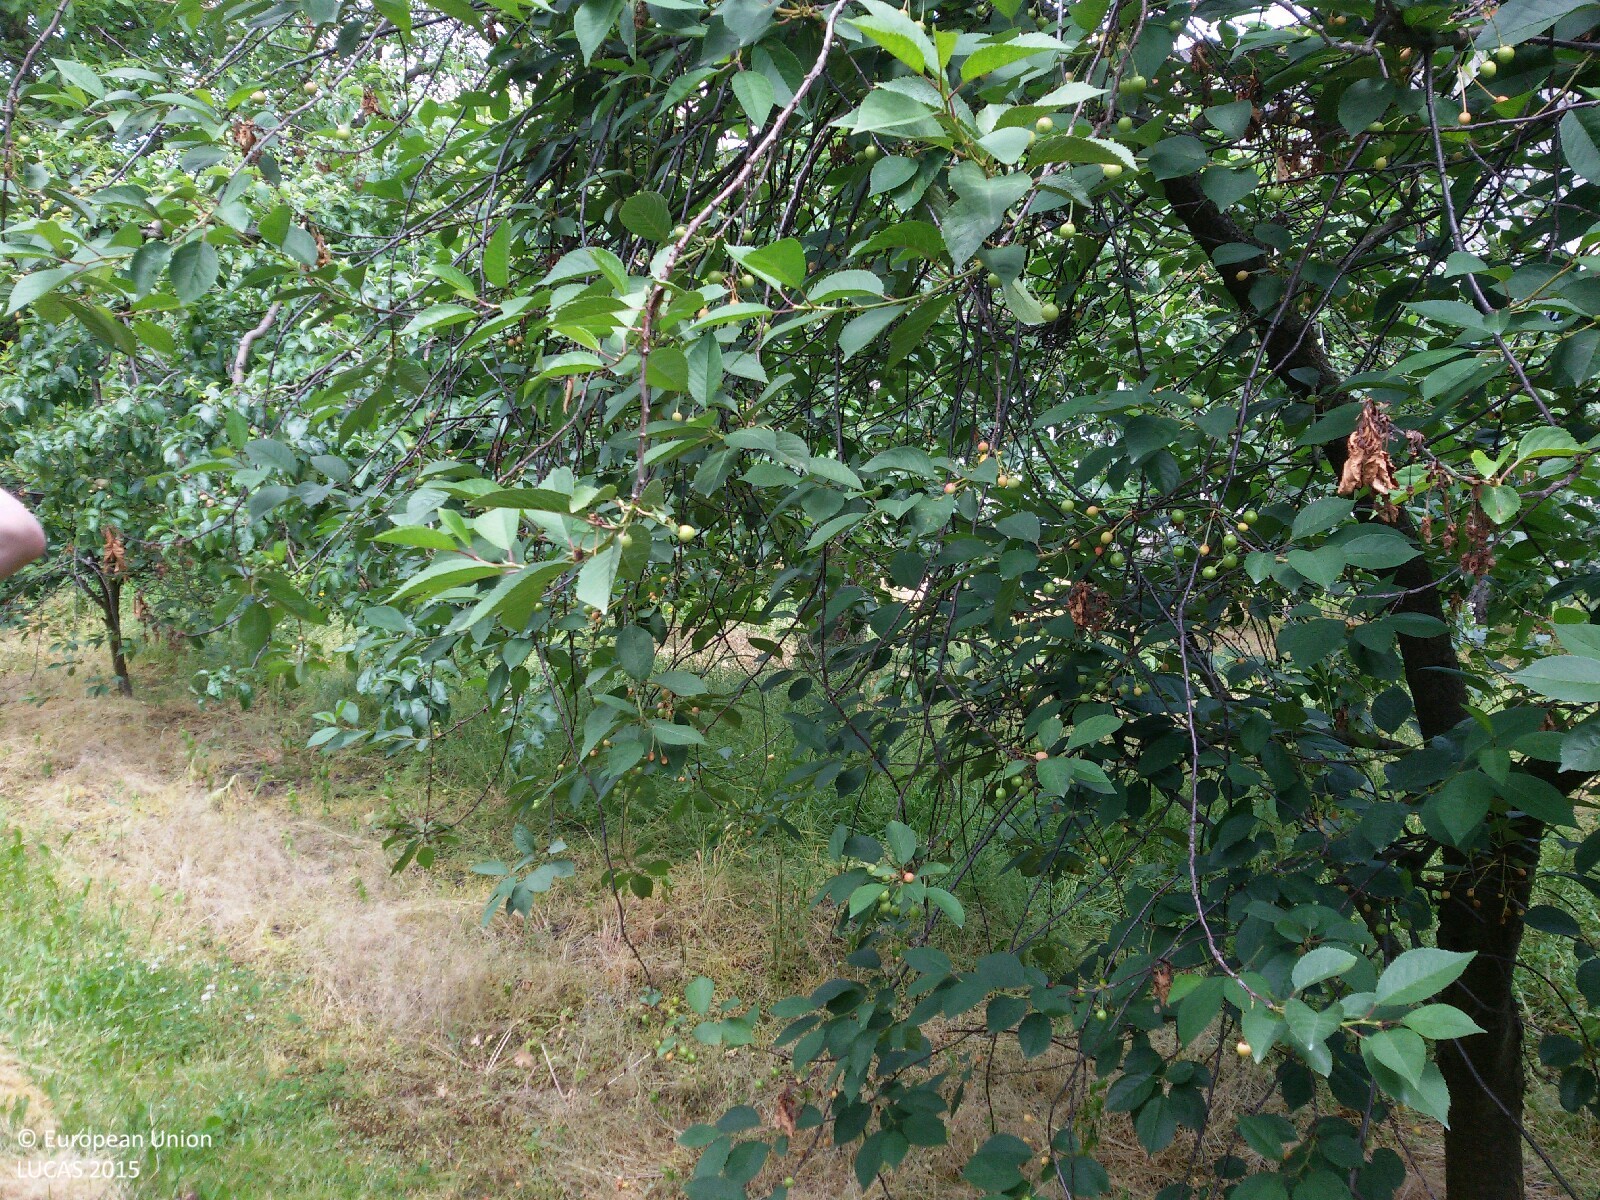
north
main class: Cropland
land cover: Cherry fruit
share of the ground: > 75 %
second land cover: Grassland without tree/shrub cover
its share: > 75 %
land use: Agriculture (excluding fallow land and kitchen gardens)
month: June
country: PL
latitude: 51.7765
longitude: 21.1632
